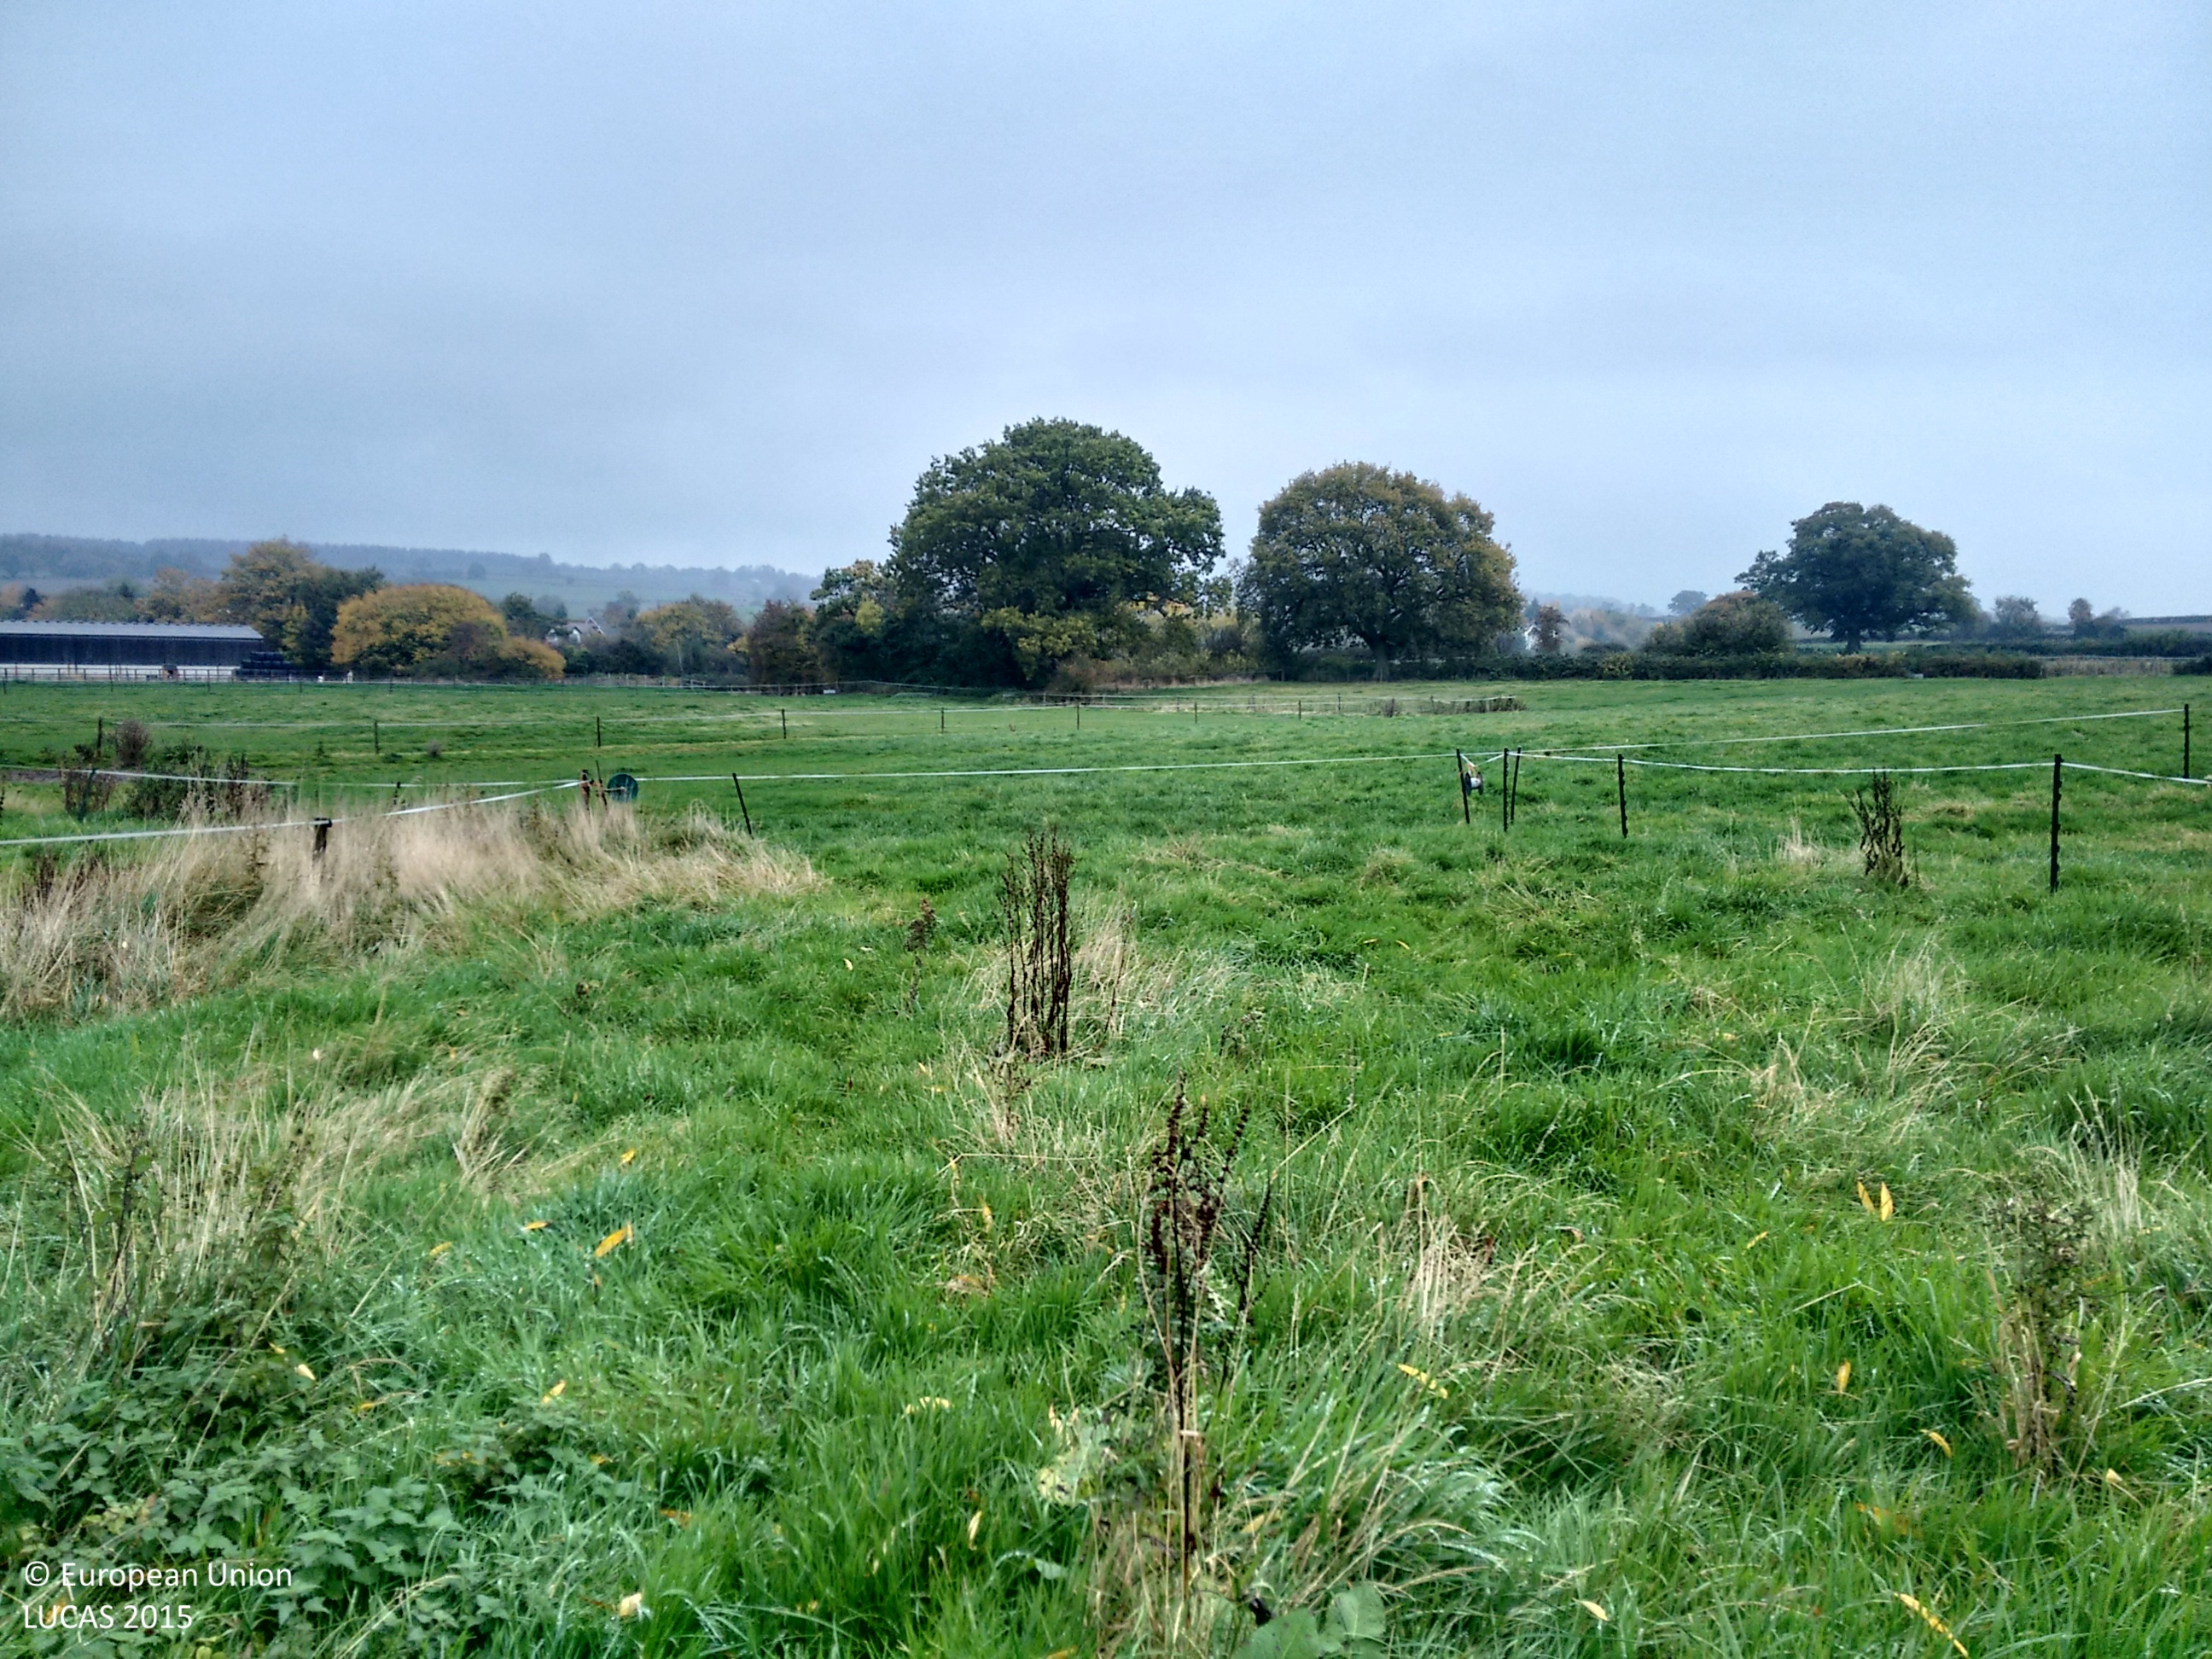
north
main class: Woodland
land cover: Broadleaved woodland
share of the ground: > 75 %
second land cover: Grassland without tree/shrub cover
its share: > 75 %
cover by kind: herbaceous plants 70 %, broadleaved forest trees 30 %
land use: Agriculture (excluding fallow land and kitchen gardens)
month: October
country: GB
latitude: 52.4731
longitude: -2.7160
